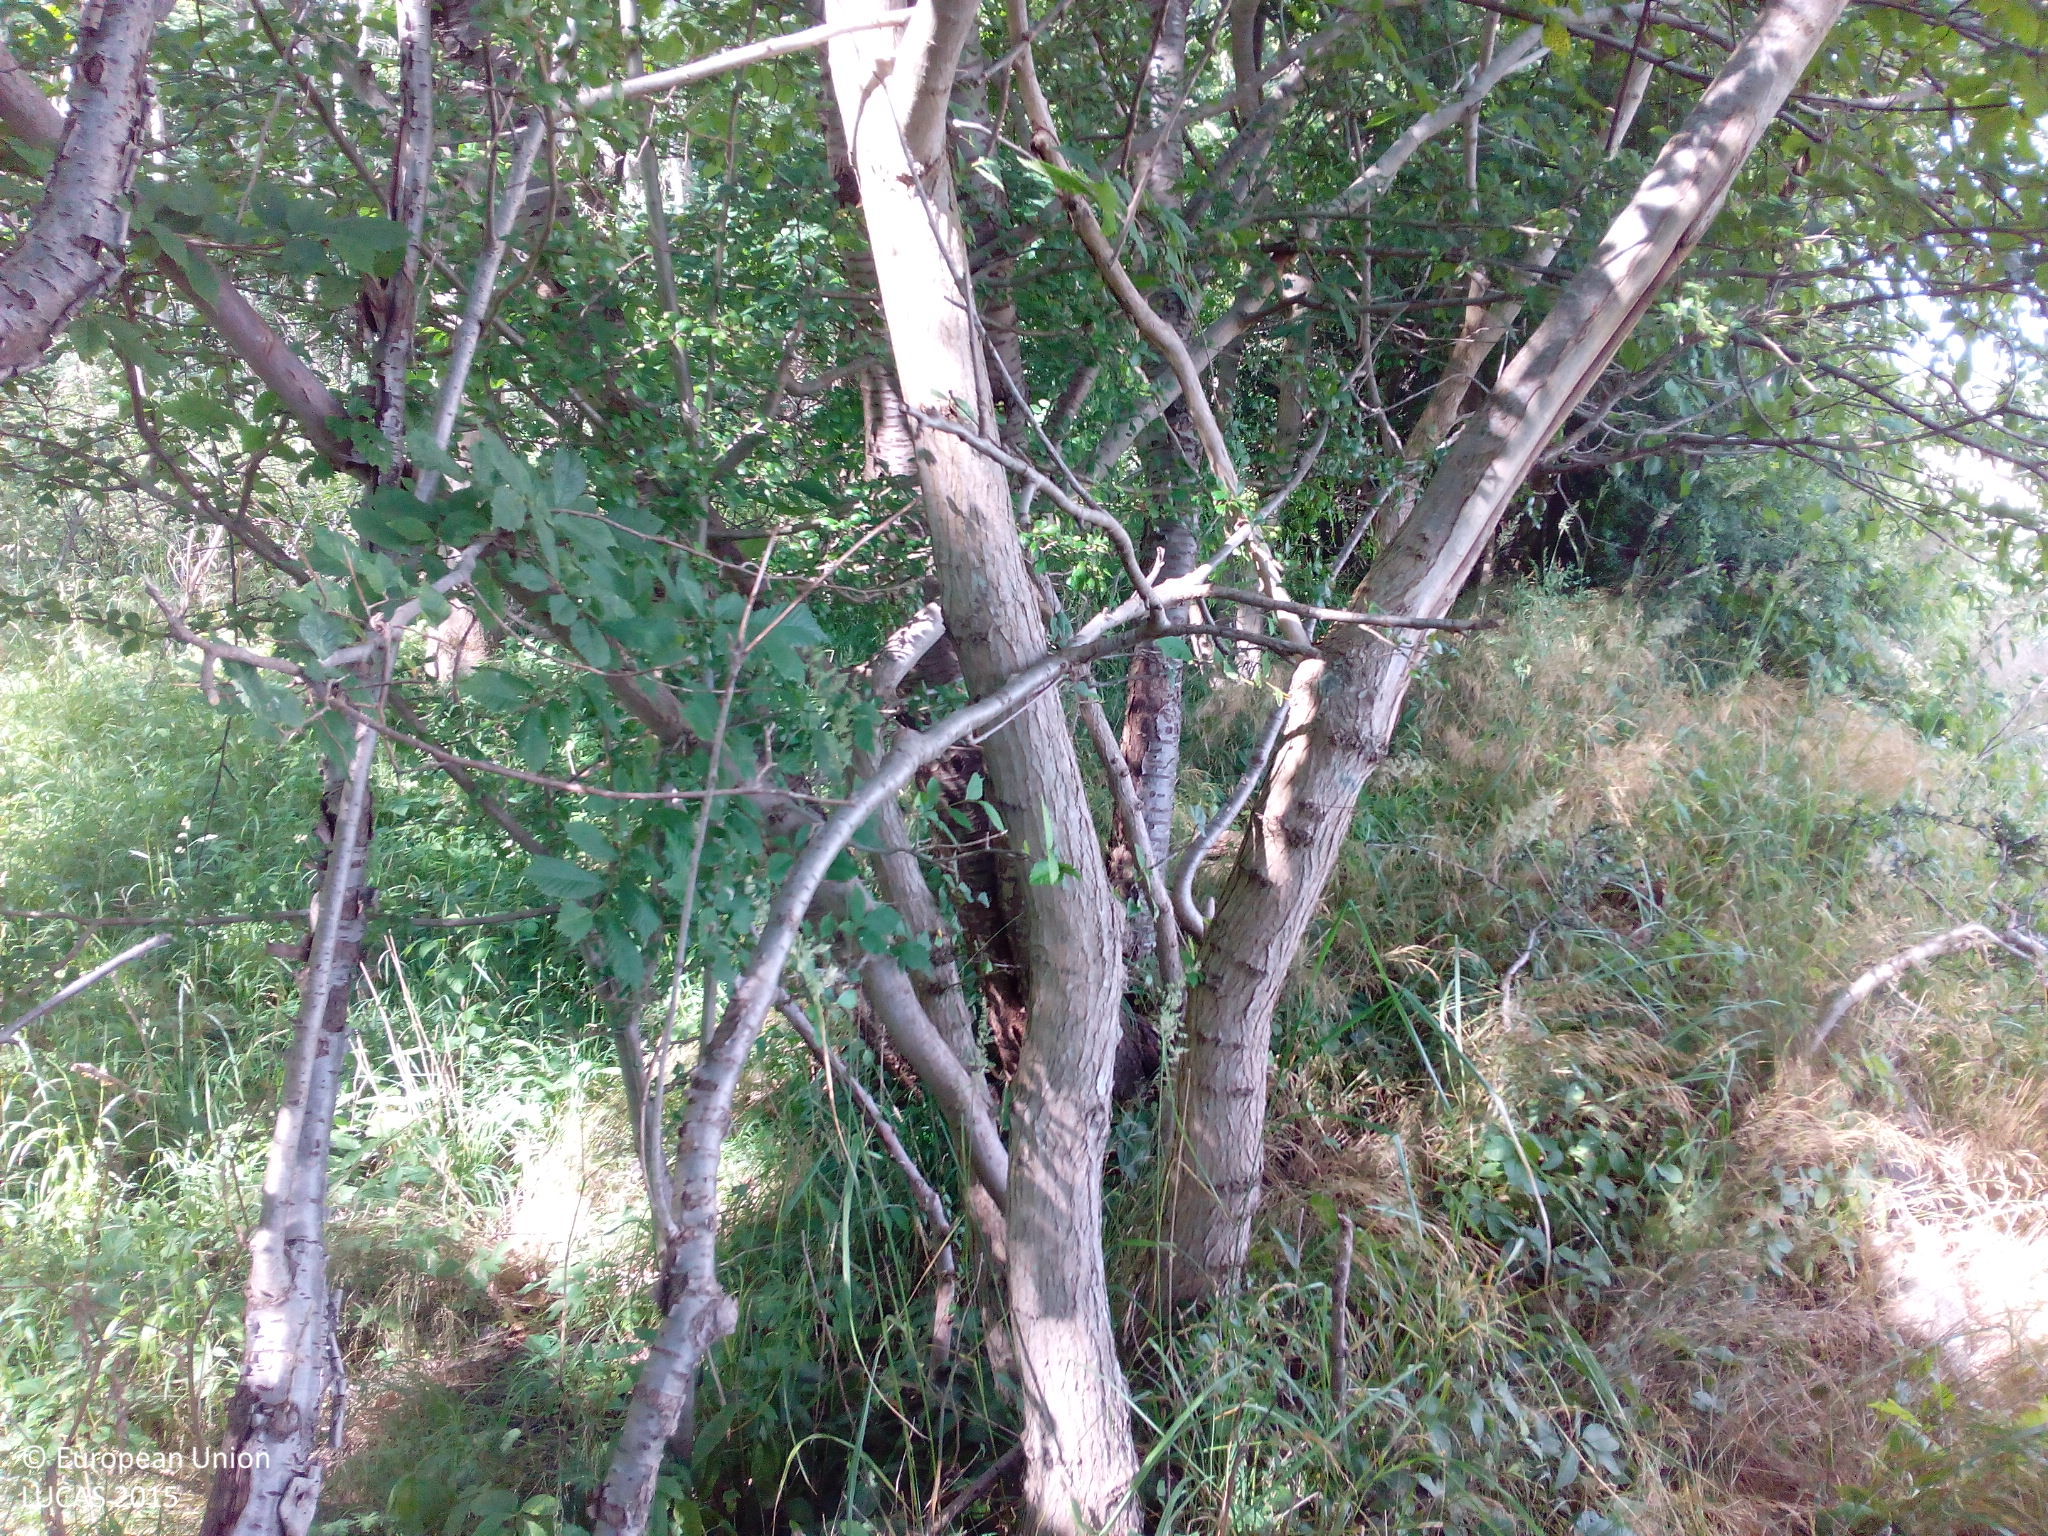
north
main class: Woodland
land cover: Broadleaved woodland
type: acidophilous oak and oak-birch forest
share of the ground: > 75 %
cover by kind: broadleaved forest trees 100 %
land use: Forestry
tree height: > 5 m
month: July
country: DK
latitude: 55.9574
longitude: 11.9362
